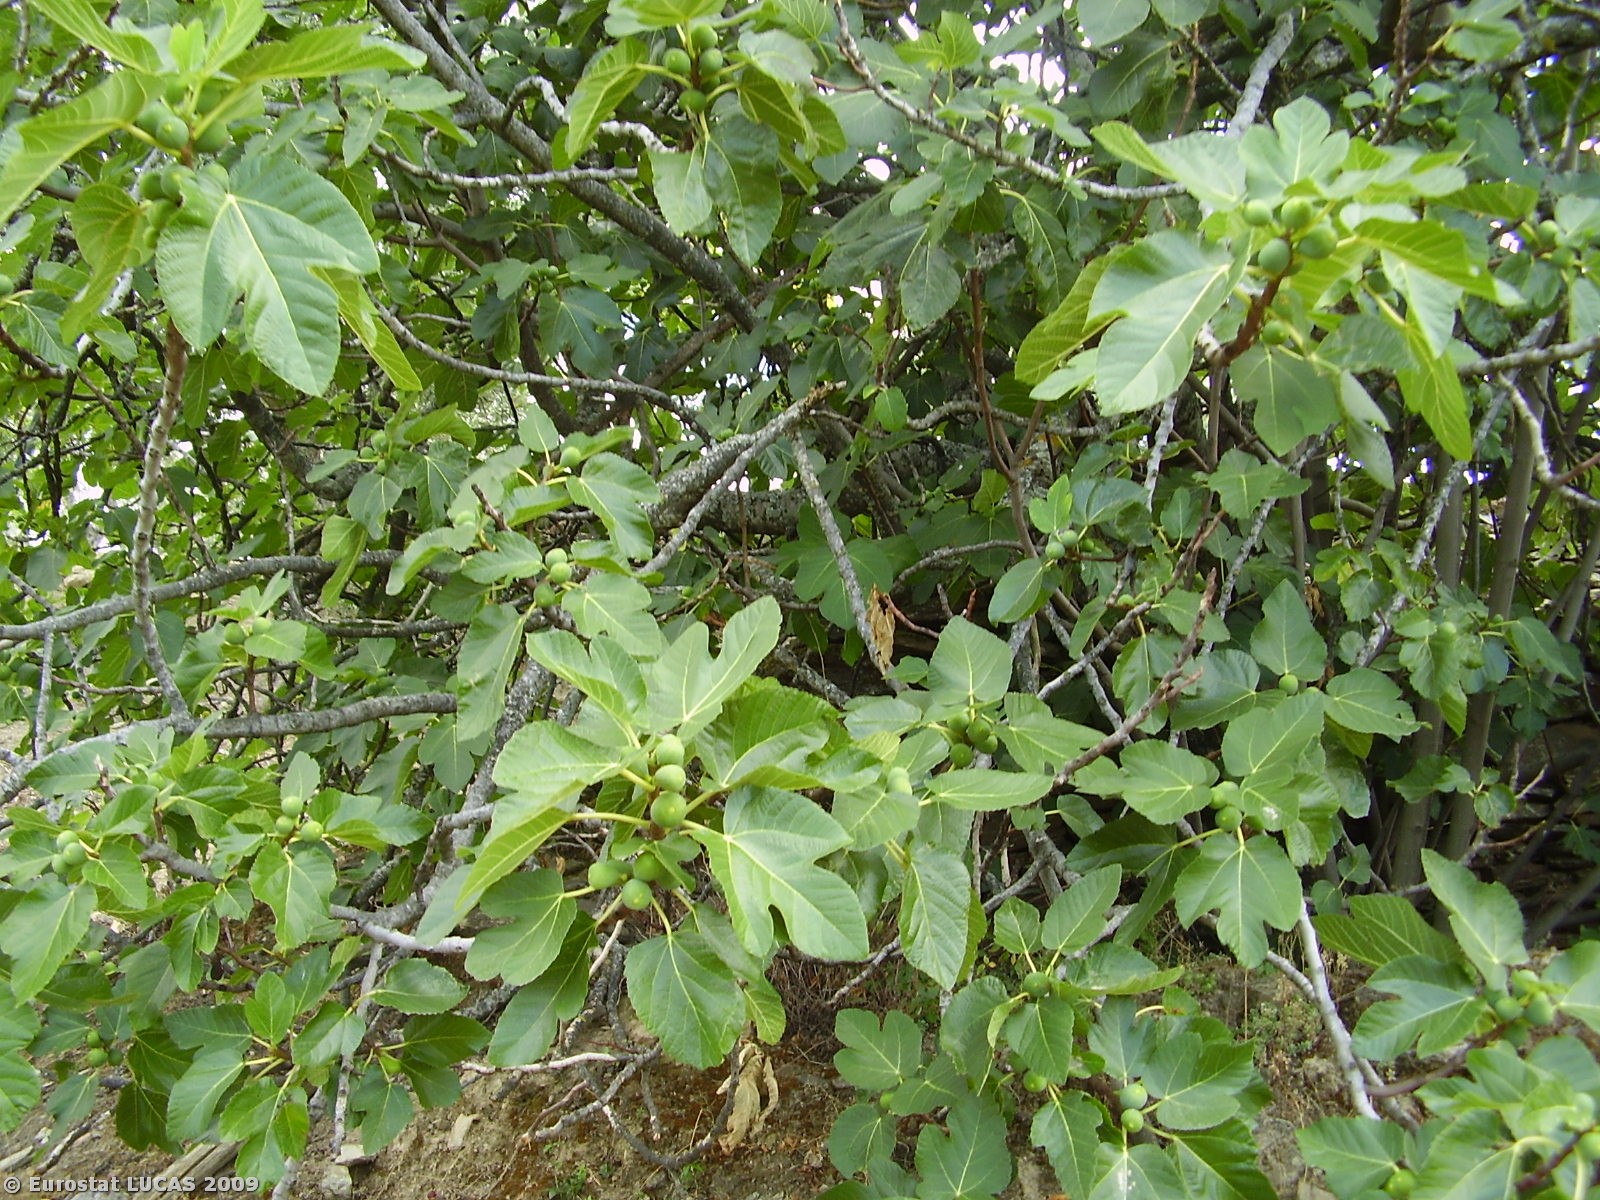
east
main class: Cropland
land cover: Vineyards
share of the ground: < 10 %
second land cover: Bare land
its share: < 10 %
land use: Agriculture (excluding fallow land and kitchen gardens)
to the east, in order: Vineyards; Dry stone walls; Single bushes/trees; Dry stone walls; Managed hedges; Dry stone walls; Tracks; Dry stone walls; Olive groves; Dry stone walls; Olive groves; Dry stone walls; Olive groves; Dry stone walls; Vineyards; Dry stone walls; Vineyards; Dry stone walls; Vineyards; Dry stone walls; Vineyards; Dry stone walls; Vineyards; Dry stone walls; Vineyards; Dry stone walls; Vineyards; Dry stone walls; Olive groves; Dry stone walls; Olive groves; Other structural elements; Vineyards; Tracks; Vineyards; Other structural elements; Tracks; Other structural elements; Vineyards
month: July
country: PT
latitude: 41.2397
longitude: -7.5325
